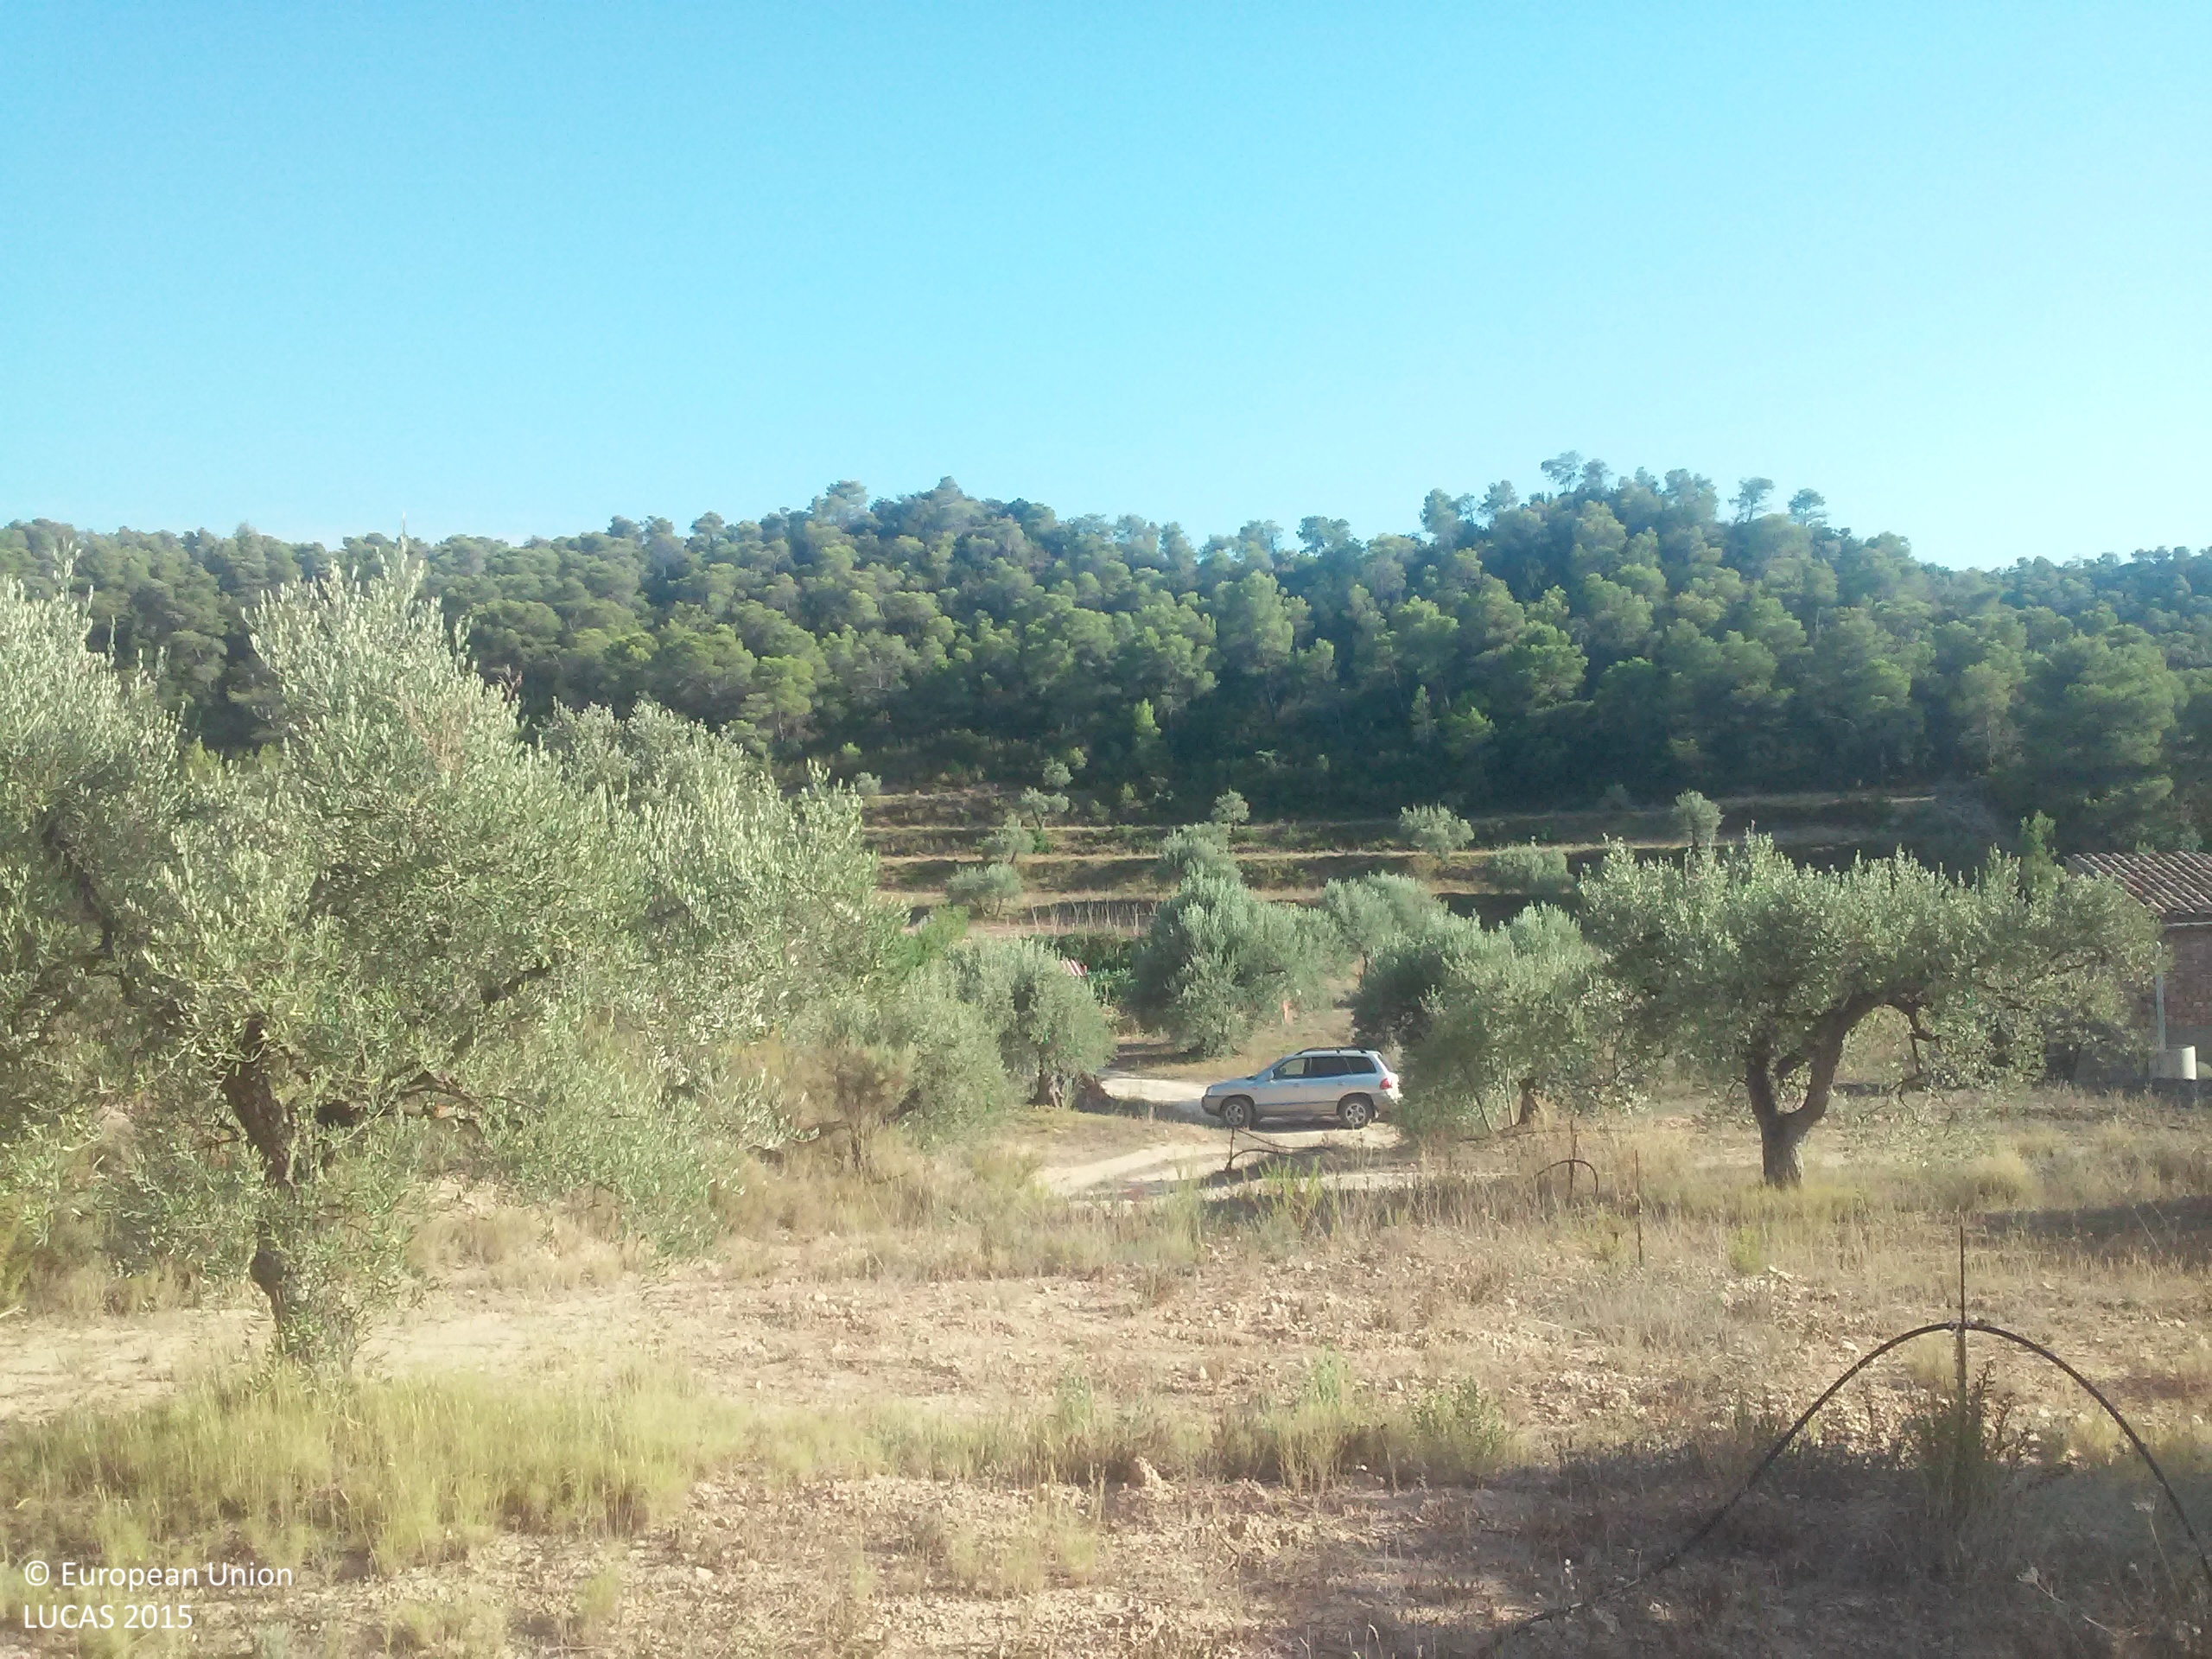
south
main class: Cropland
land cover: Olive groves
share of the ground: 10 - 25 %
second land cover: Grassland without tree/shrub cover
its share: > 75 %
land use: Agriculture (excluding fallow land and kitchen gardens)
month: August
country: ES
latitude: 41.2524
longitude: 0.5983
